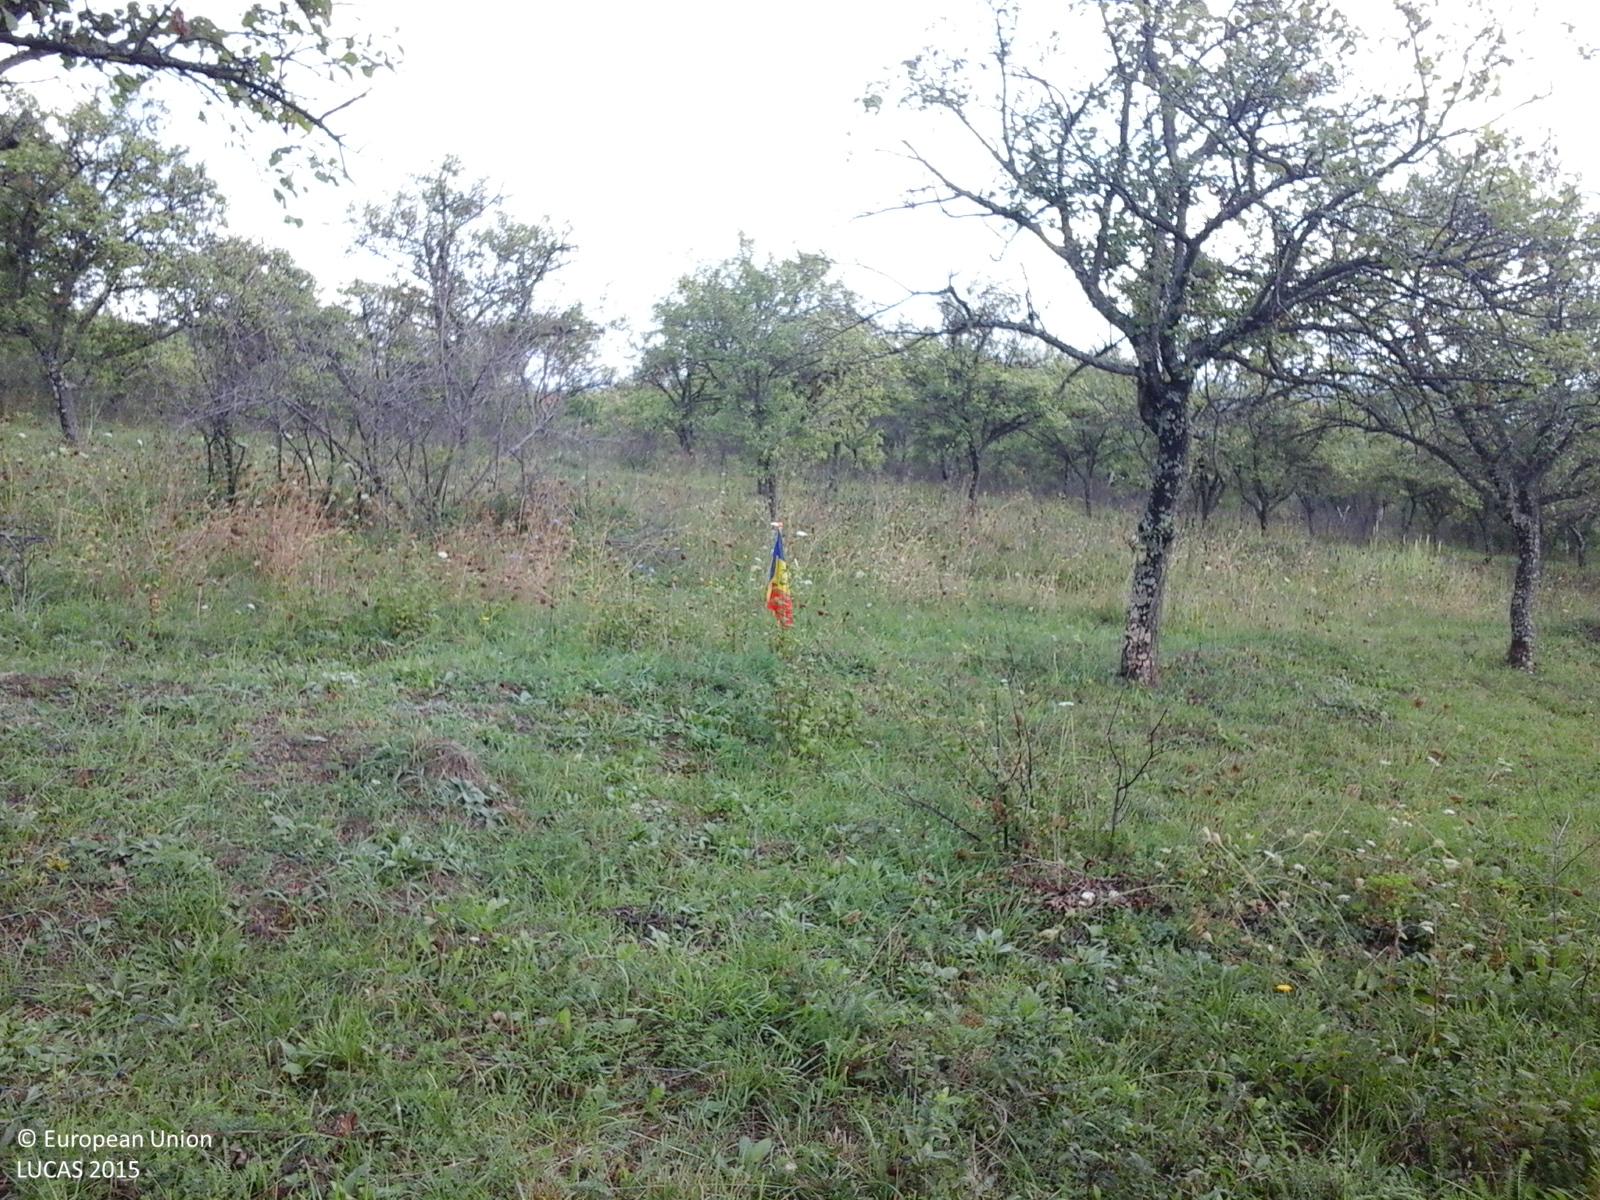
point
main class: Cropland
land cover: Other fruit trees and berries
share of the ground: 50 - 75 %
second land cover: Grassland without tree/shrub cover
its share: > 75 %
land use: Agriculture (excluding fallow land and kitchen gardens)
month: September
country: RO
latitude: 45.2100
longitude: 24.5031
